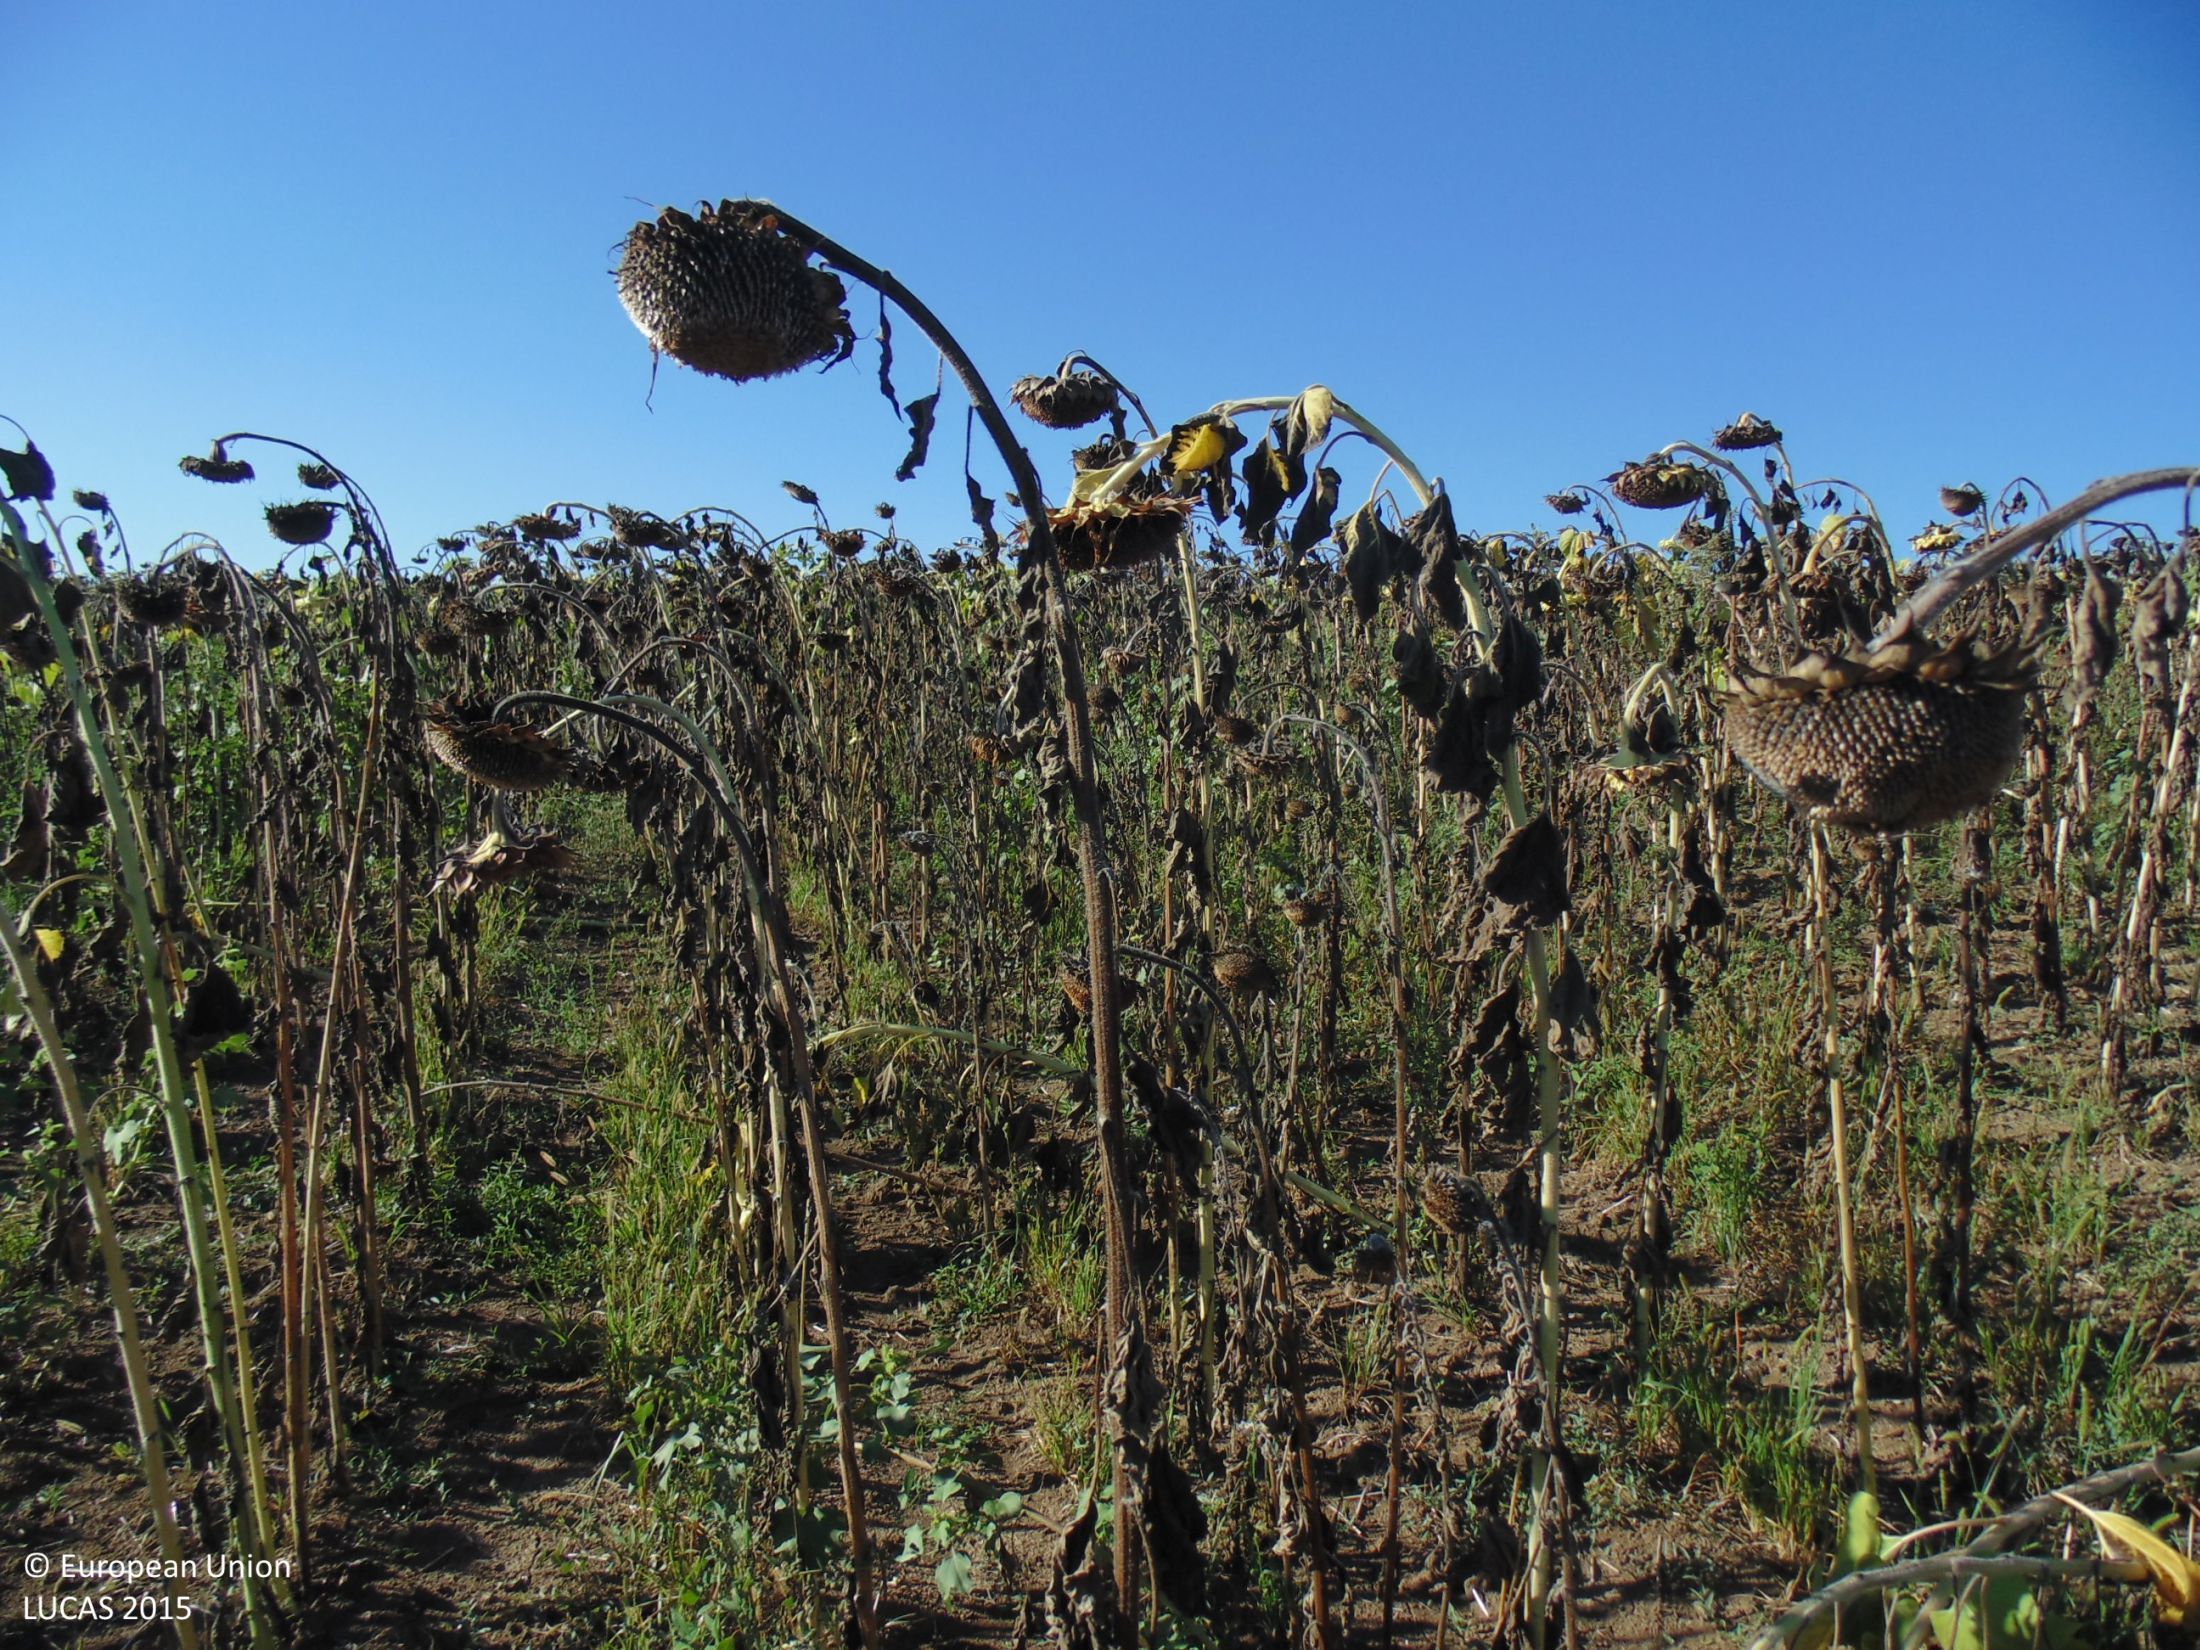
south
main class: Cropland
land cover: Sunflower
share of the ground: > 75 %
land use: Agriculture (excluding fallow land and kitchen gardens)
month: September
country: BG
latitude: 43.7612
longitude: 27.2307
